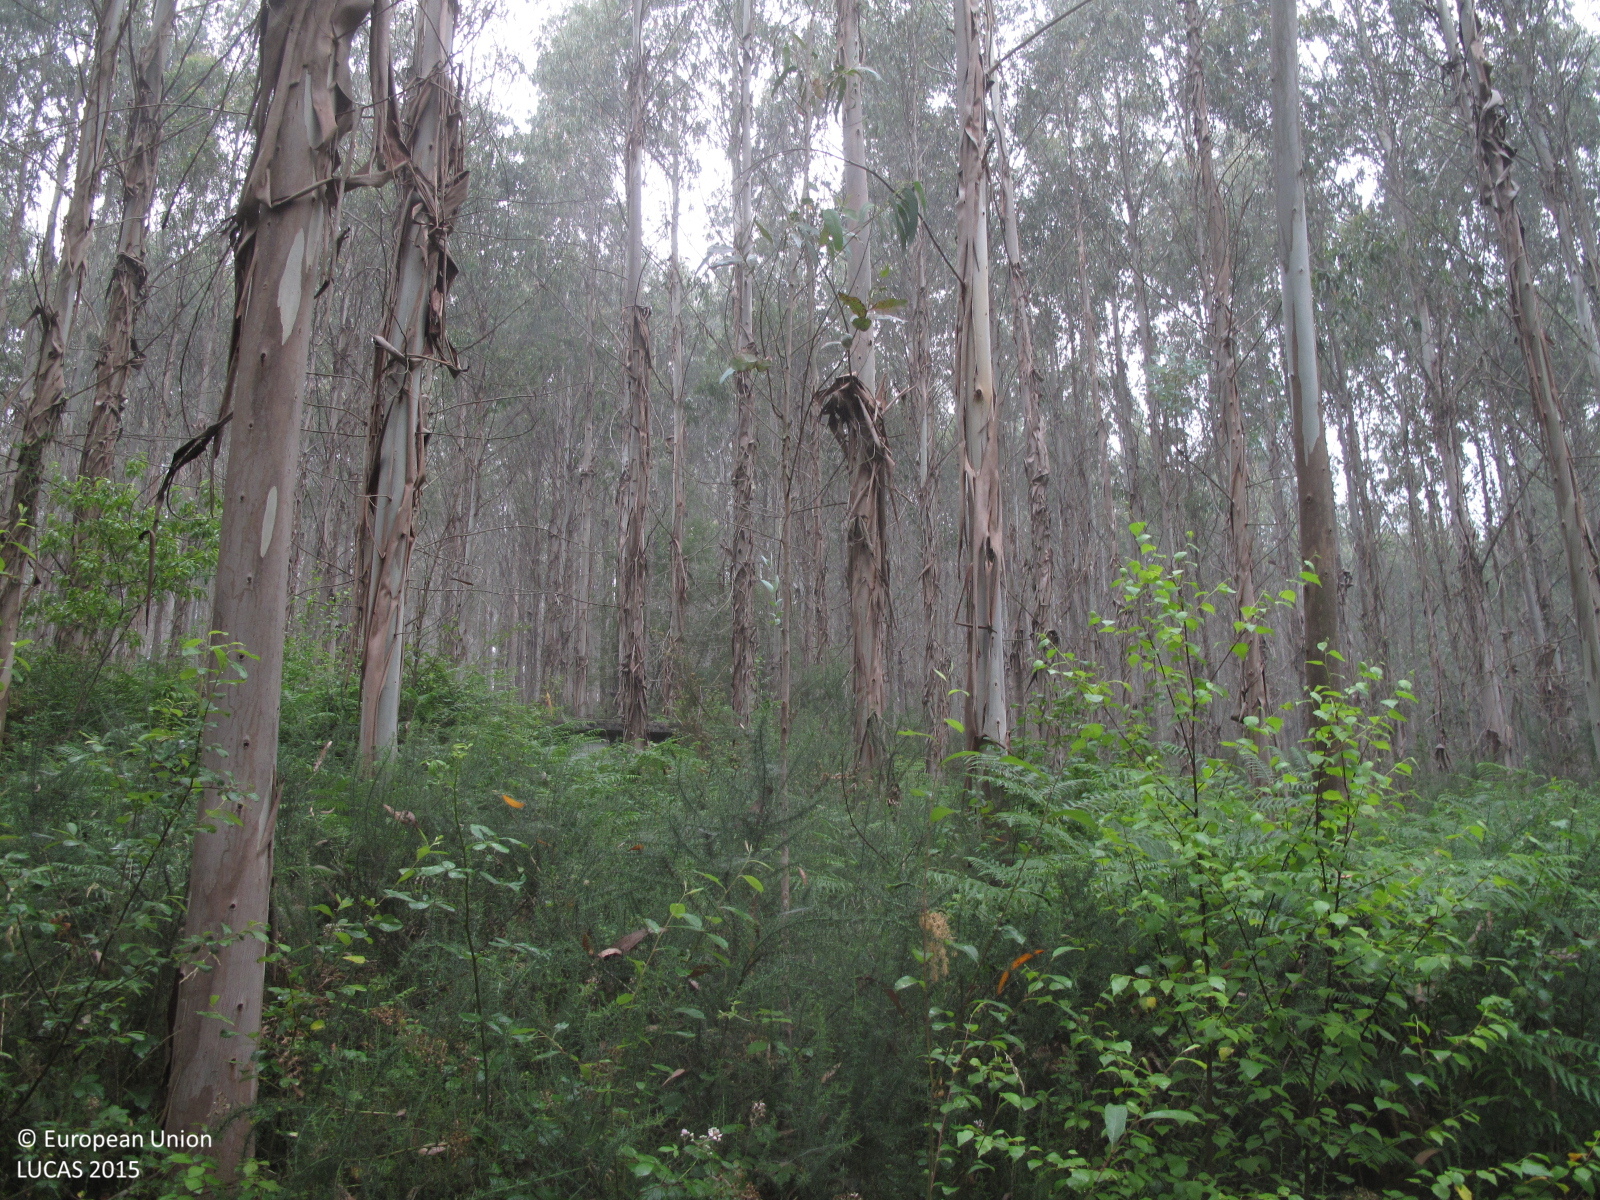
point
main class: Woodland
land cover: Broadleaved woodland
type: exotic forest
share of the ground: 50 - 75 %
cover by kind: broadleaved forest trees 70 %, shrubs 20 %, herbaceous plants 10 %
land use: Forestry
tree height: > 5 m
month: June
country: ES
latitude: 43.1992
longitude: -8.2268
